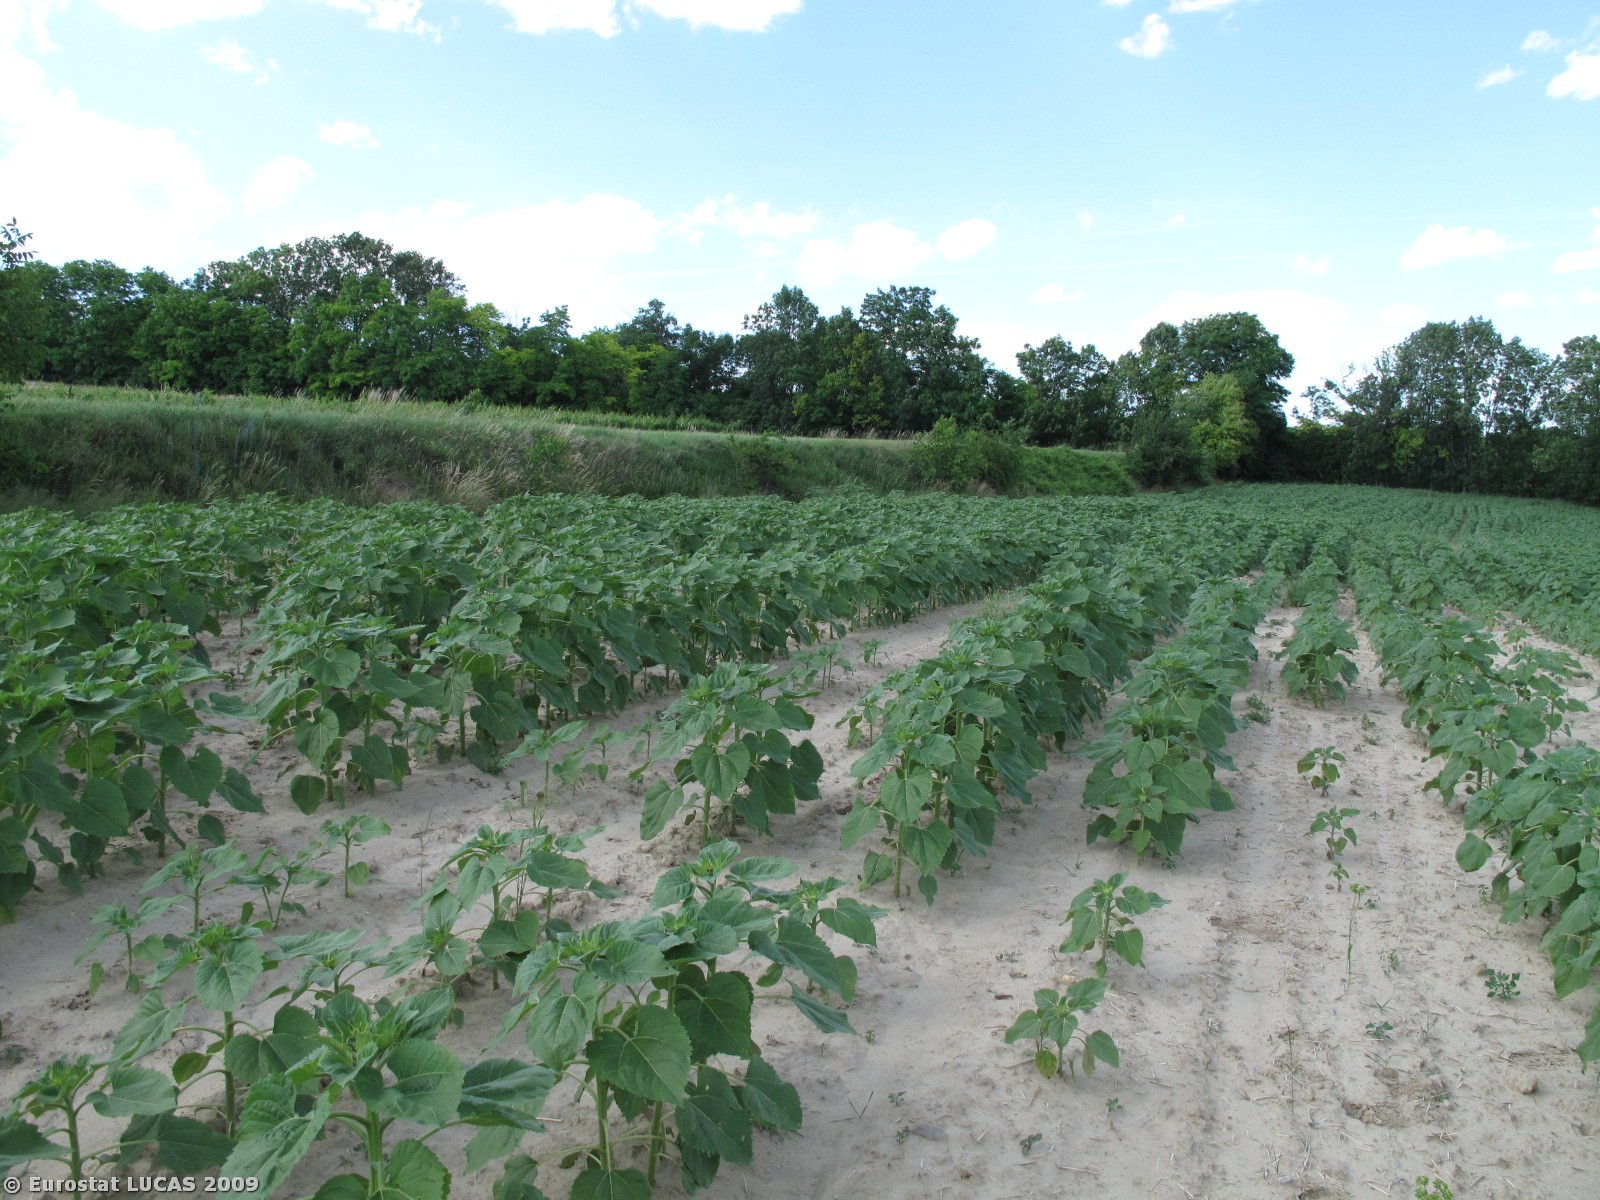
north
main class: Cropland
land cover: Sunflower
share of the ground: 25 - 50 %
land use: Agriculture (excluding fallow land and kitchen gardens)
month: June
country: AT
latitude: 48.4674
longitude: 15.8058
